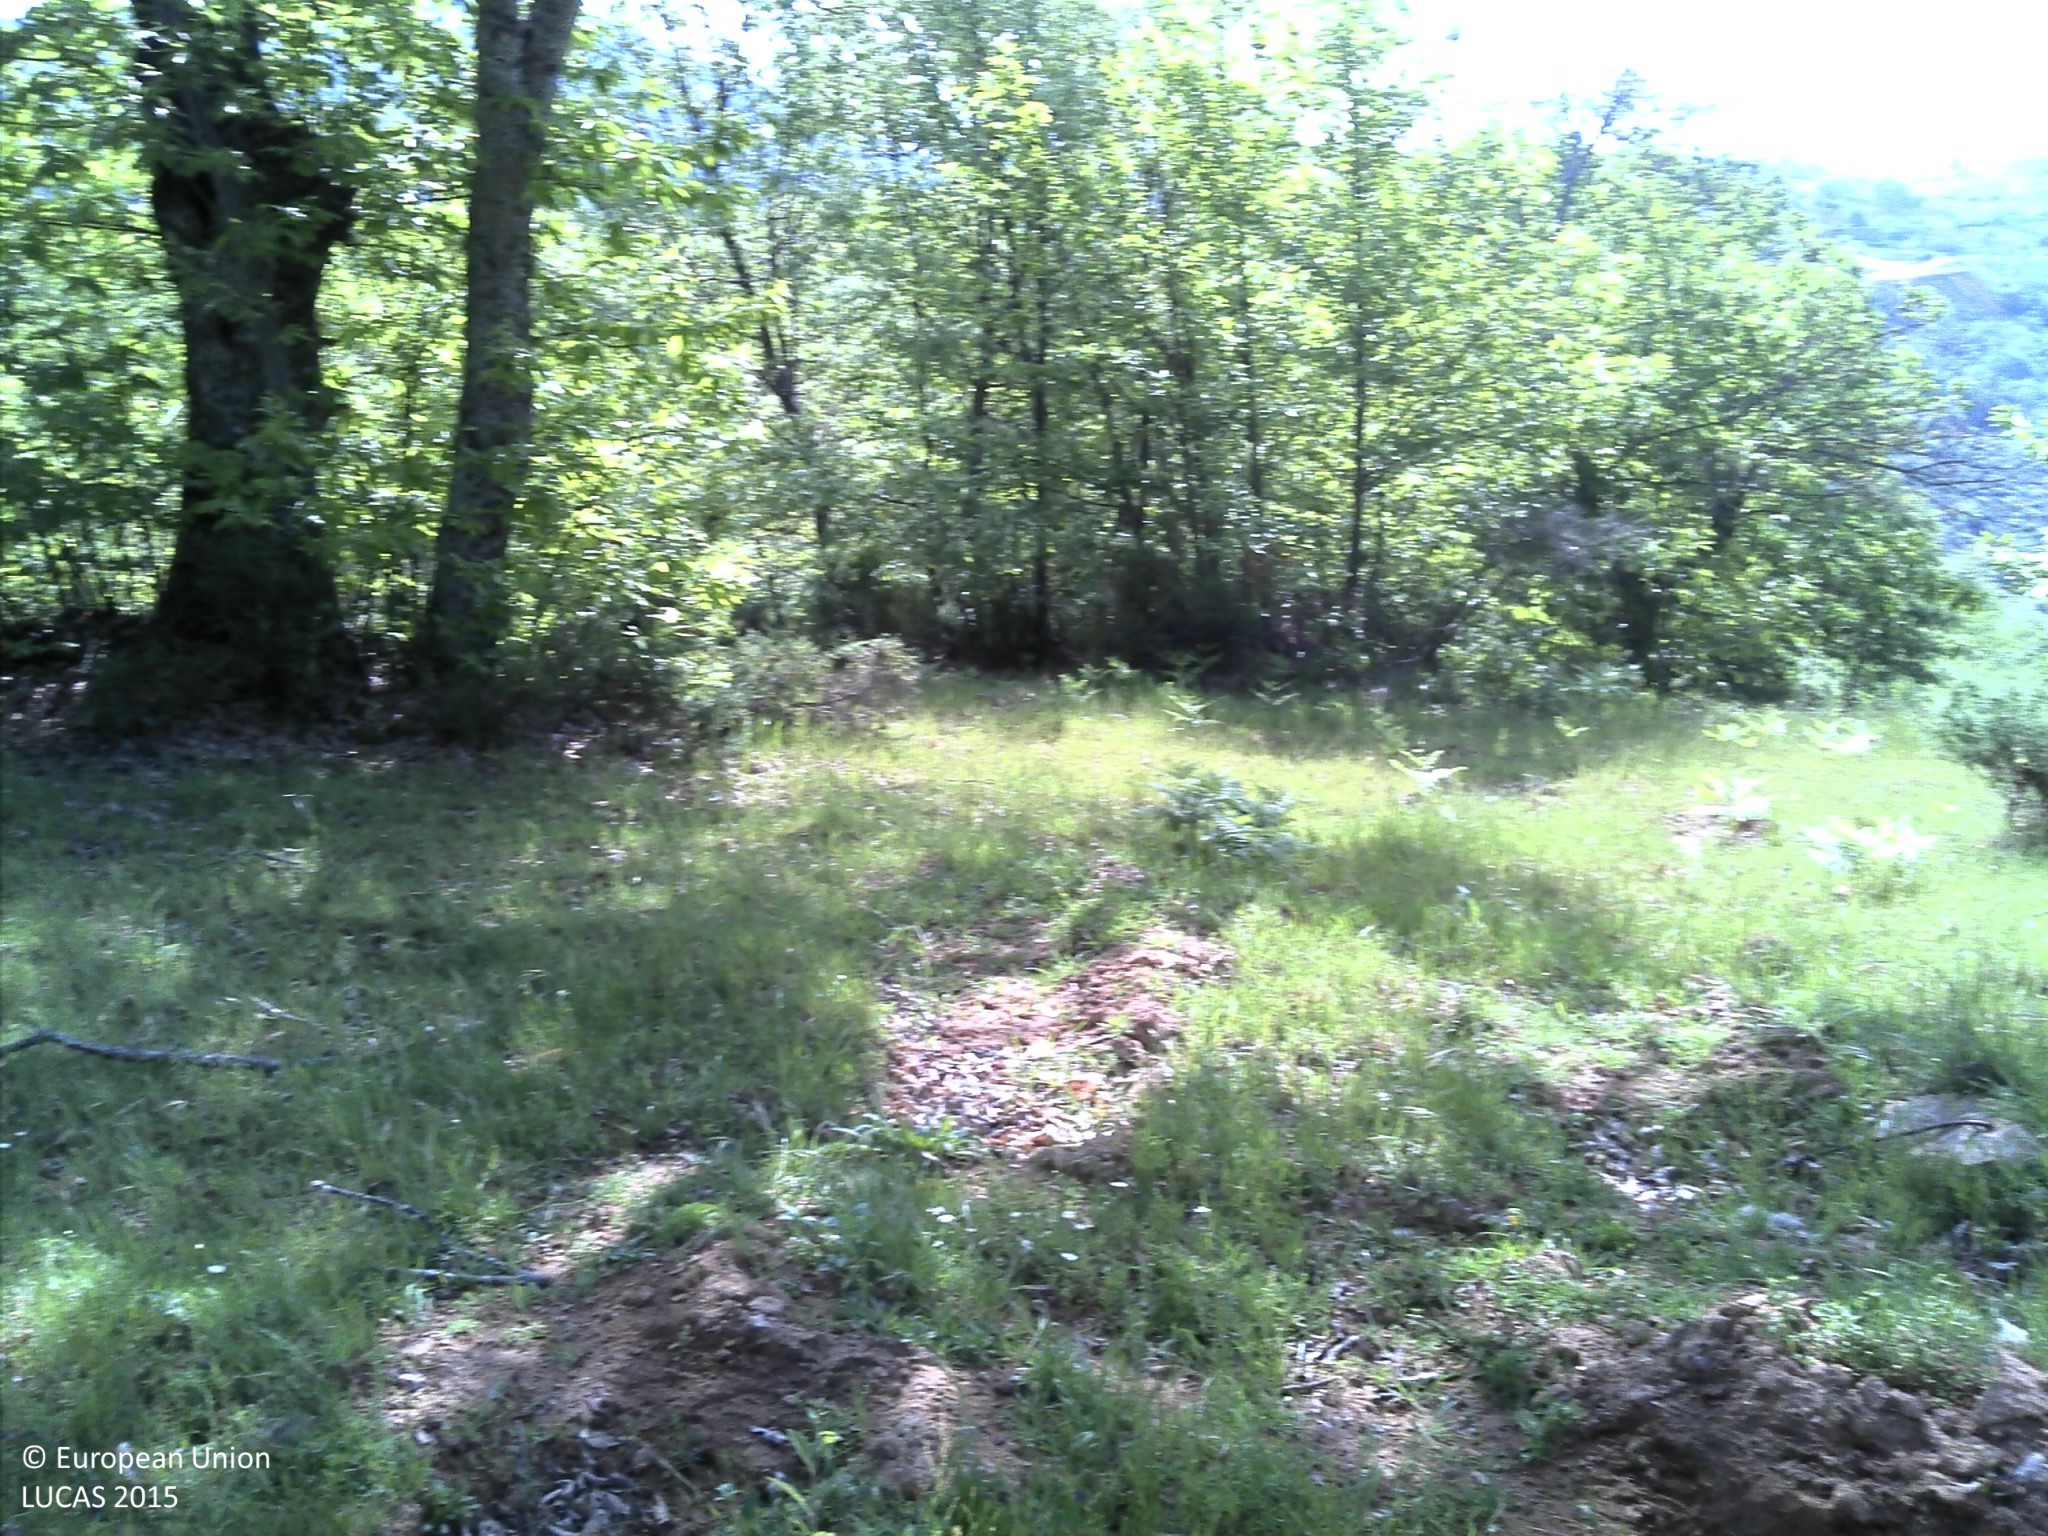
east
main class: Cropland
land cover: Nuts trees
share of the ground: 25 - 50 %
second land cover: Grassland without tree/shrub cover
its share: 25 - 50 %
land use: Agriculture (excluding fallow land and kitchen gardens)
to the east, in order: Nuts trees; Grassland without tree/shrub cover; Broadleaved woodland; Nuts trees; Shruby margins; Tracks; Grass margins; Spontaneously vegetated surfaces; Other bare soil; Abandoned hedges; Fences; Grassland without tree/shrub cover; Tracks; Fences; Grassland without tree/shrub cover
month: May
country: PT
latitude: 41.8460
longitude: -7.0176
